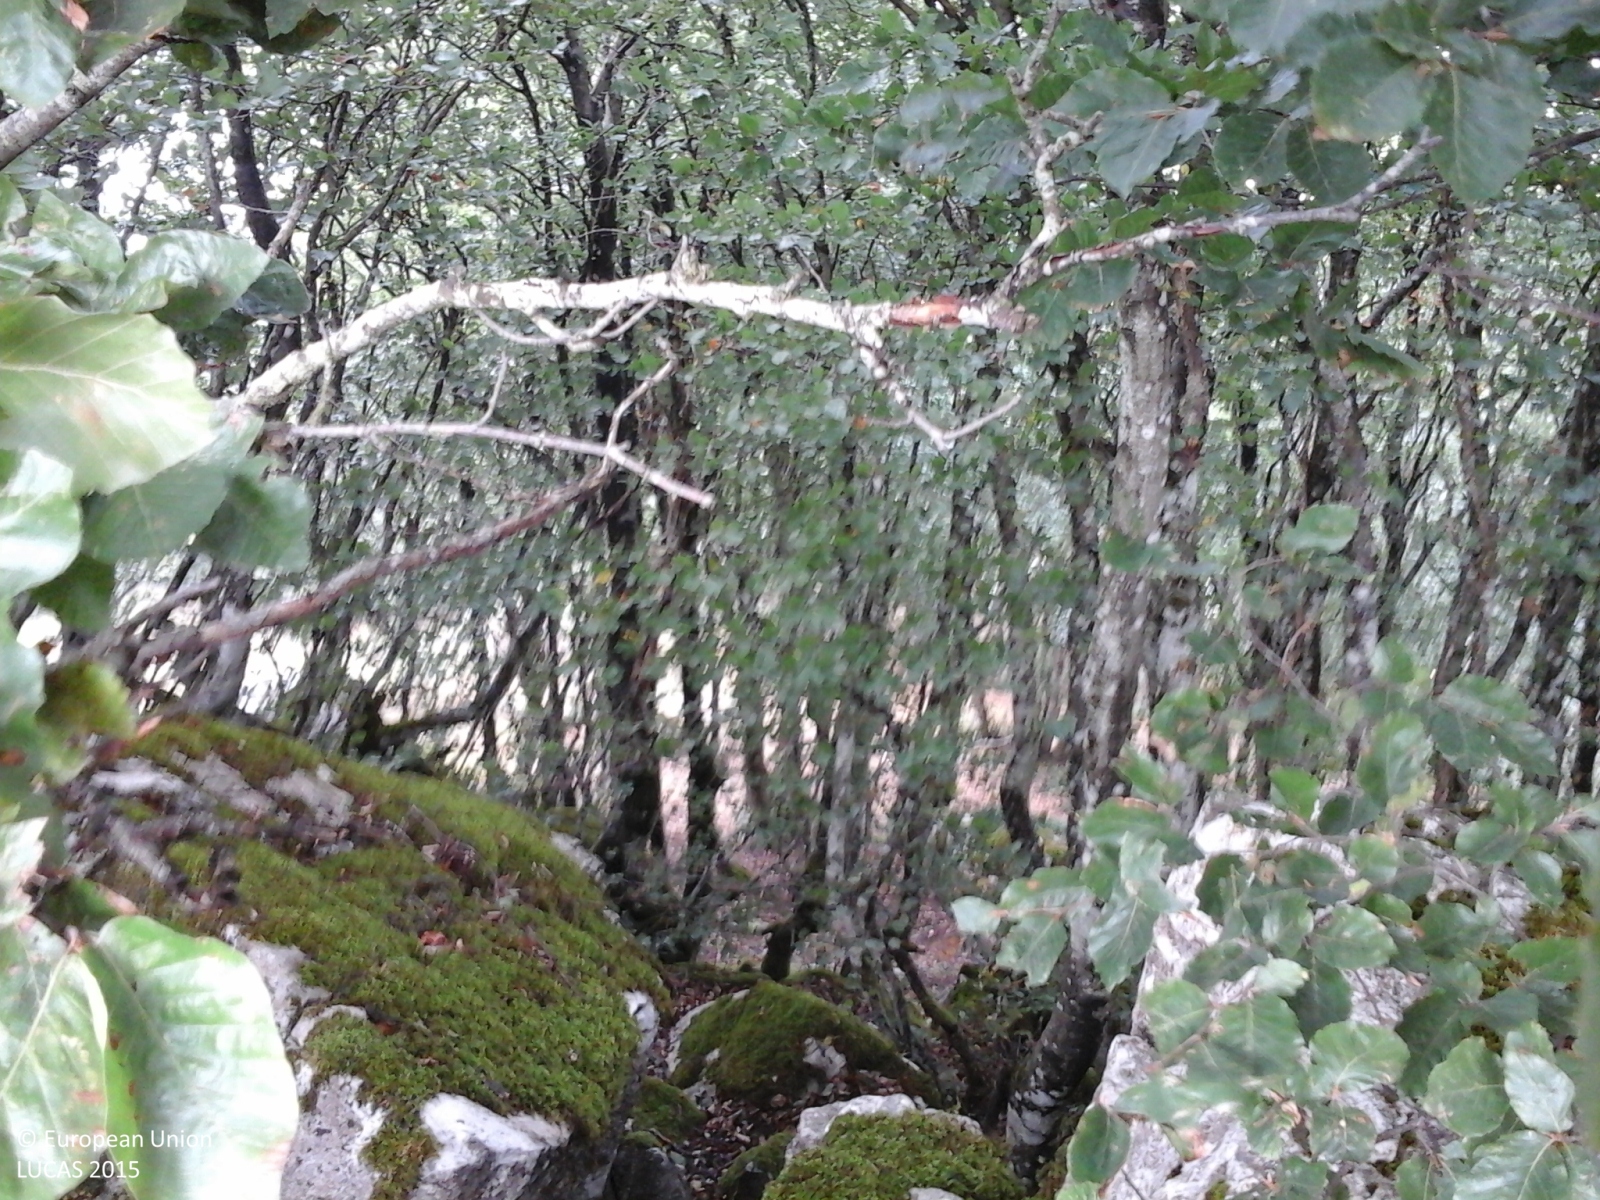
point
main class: Woodland
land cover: Broadleaved woodland
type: mountainous beech forest
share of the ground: > 75 %
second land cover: Grassland without tree/shrub cover
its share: > 75 %
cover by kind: broadleaved forest trees 70 %, shrubs 20 %, herbaceous plants 10 %
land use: Forestry
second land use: Agriculture (excluding fallow land and kitchen gardens)
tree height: > 5 m
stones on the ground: 25 - 50 %
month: September
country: IT
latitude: 41.6362
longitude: 14.3903
